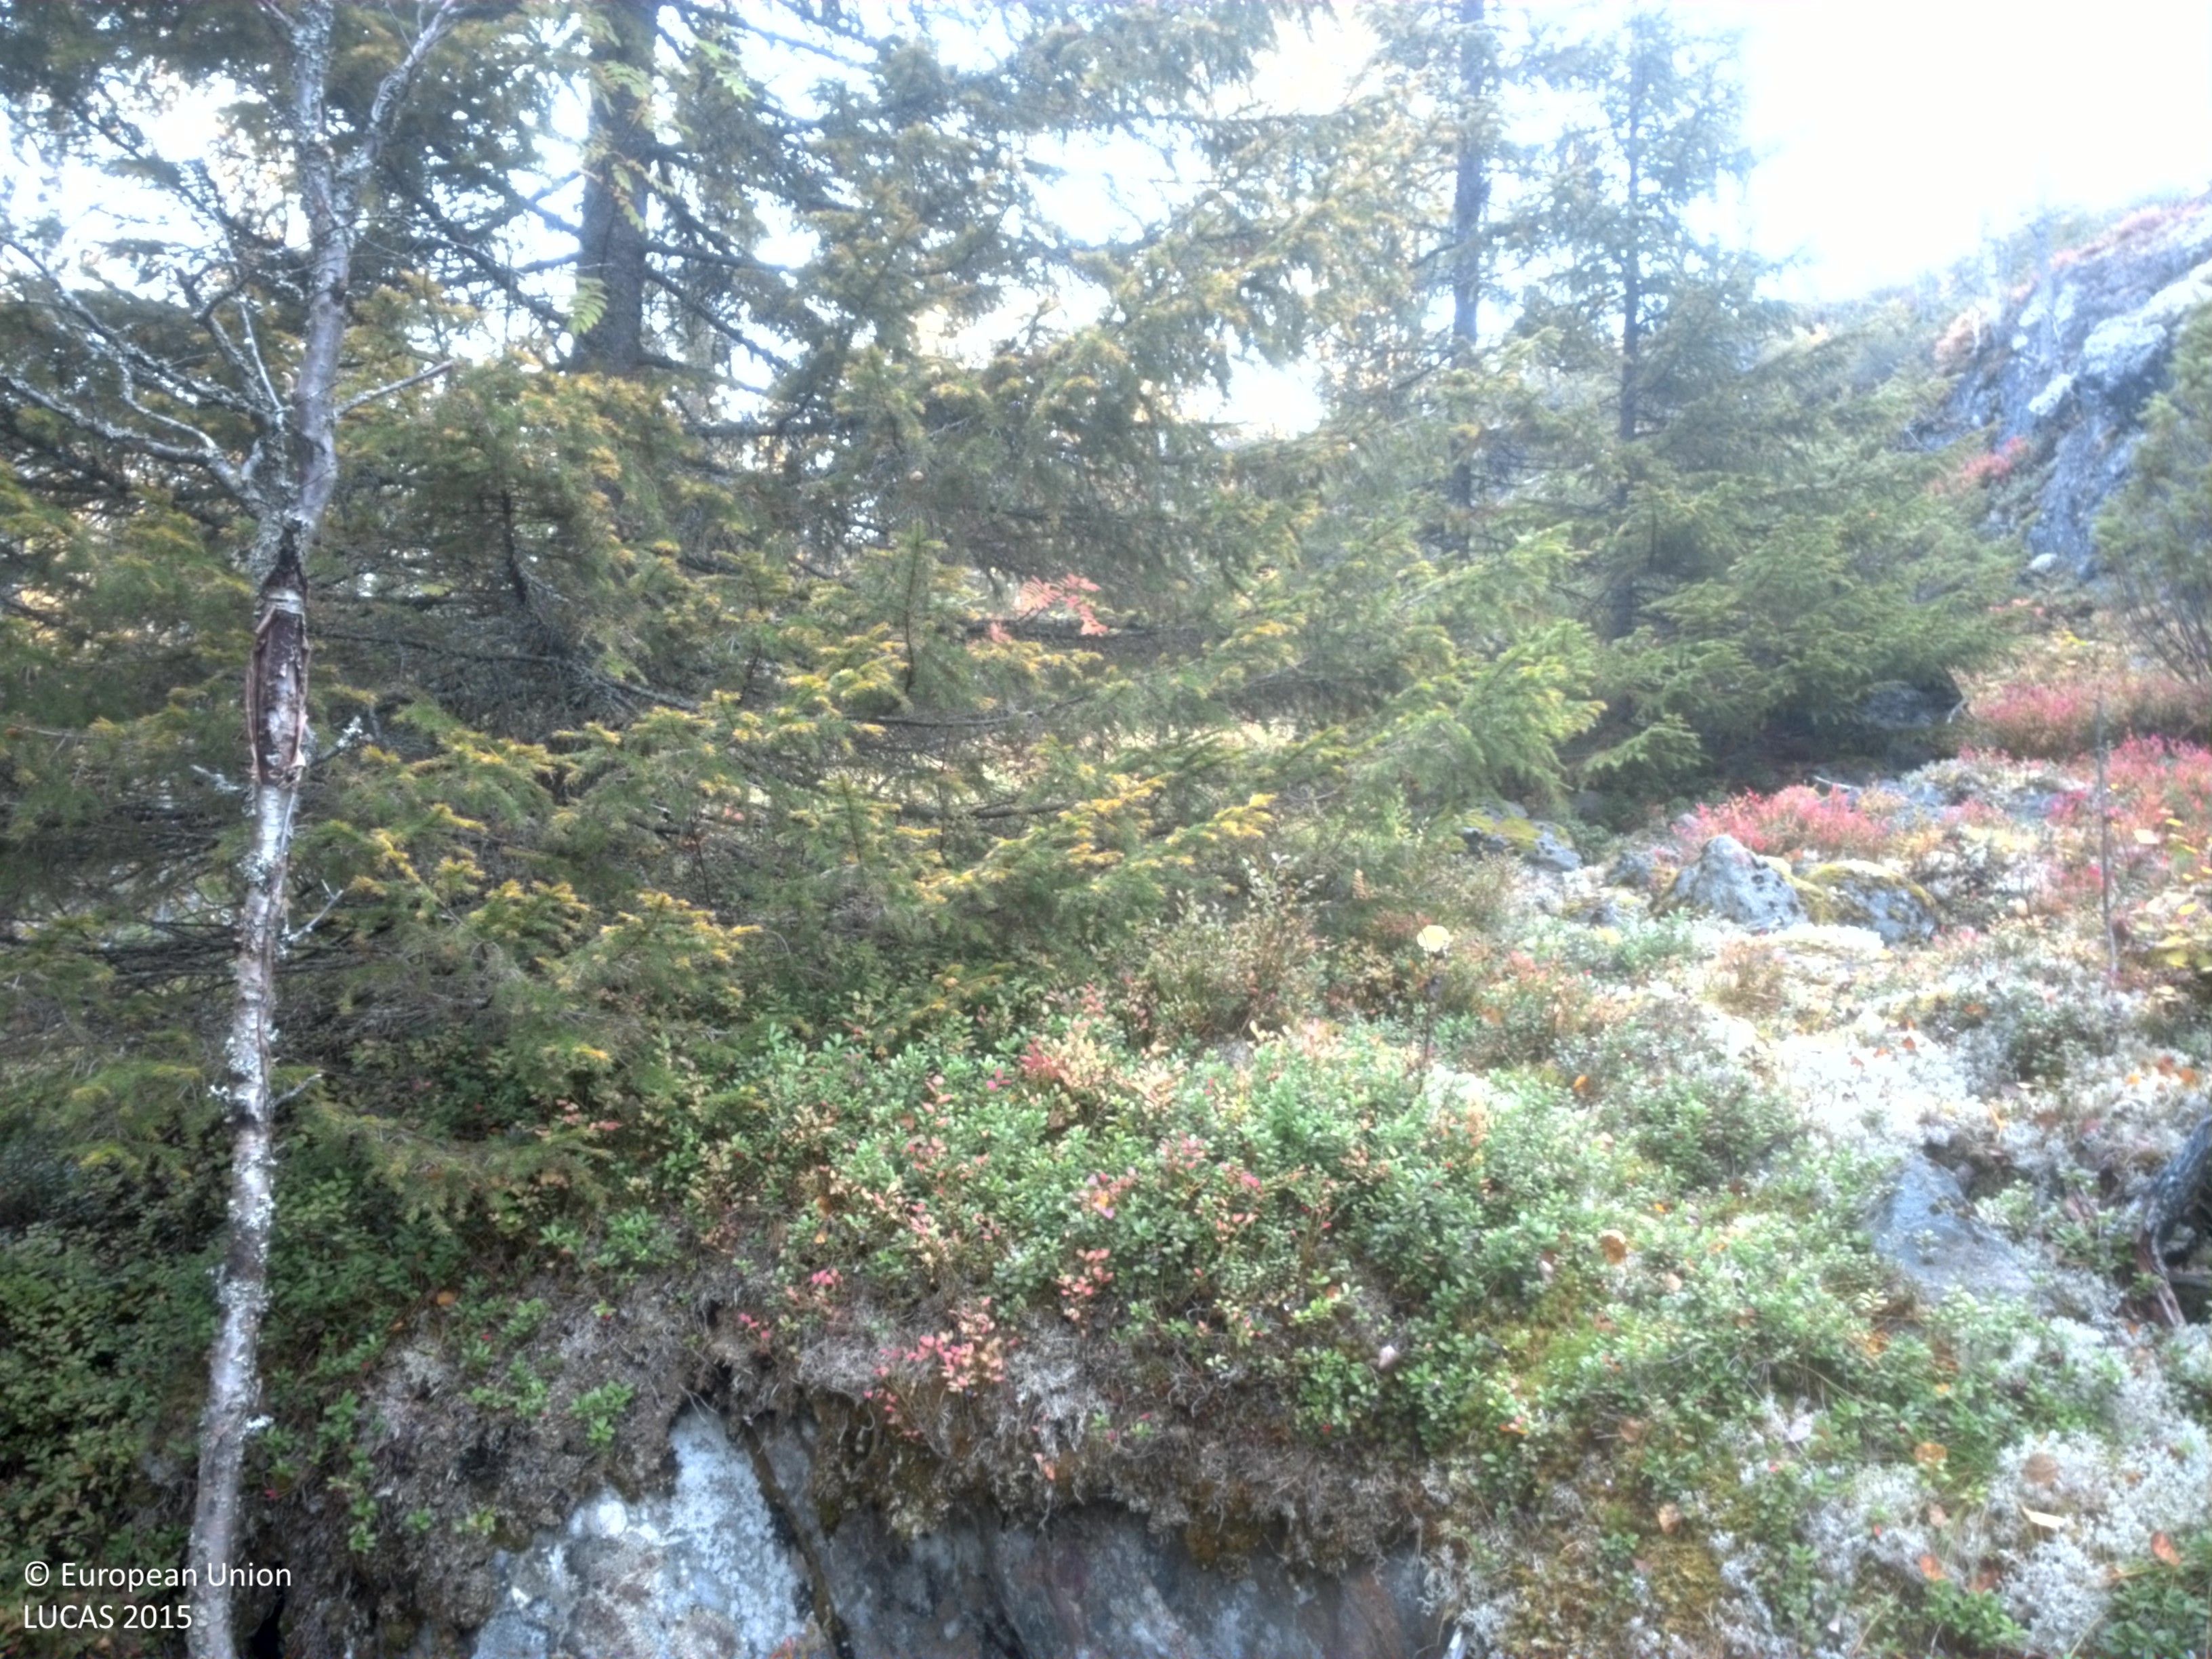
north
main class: Woodland
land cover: Other mixed woodland
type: boreal forest
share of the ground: 50 - 75 %
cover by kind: coniferous forest trees 40 %, shrubs 40 %, broadleaved forest trees 20 %
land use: Forestry
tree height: > 5 m
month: September
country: SE
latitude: 64.2624
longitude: 20.0279
